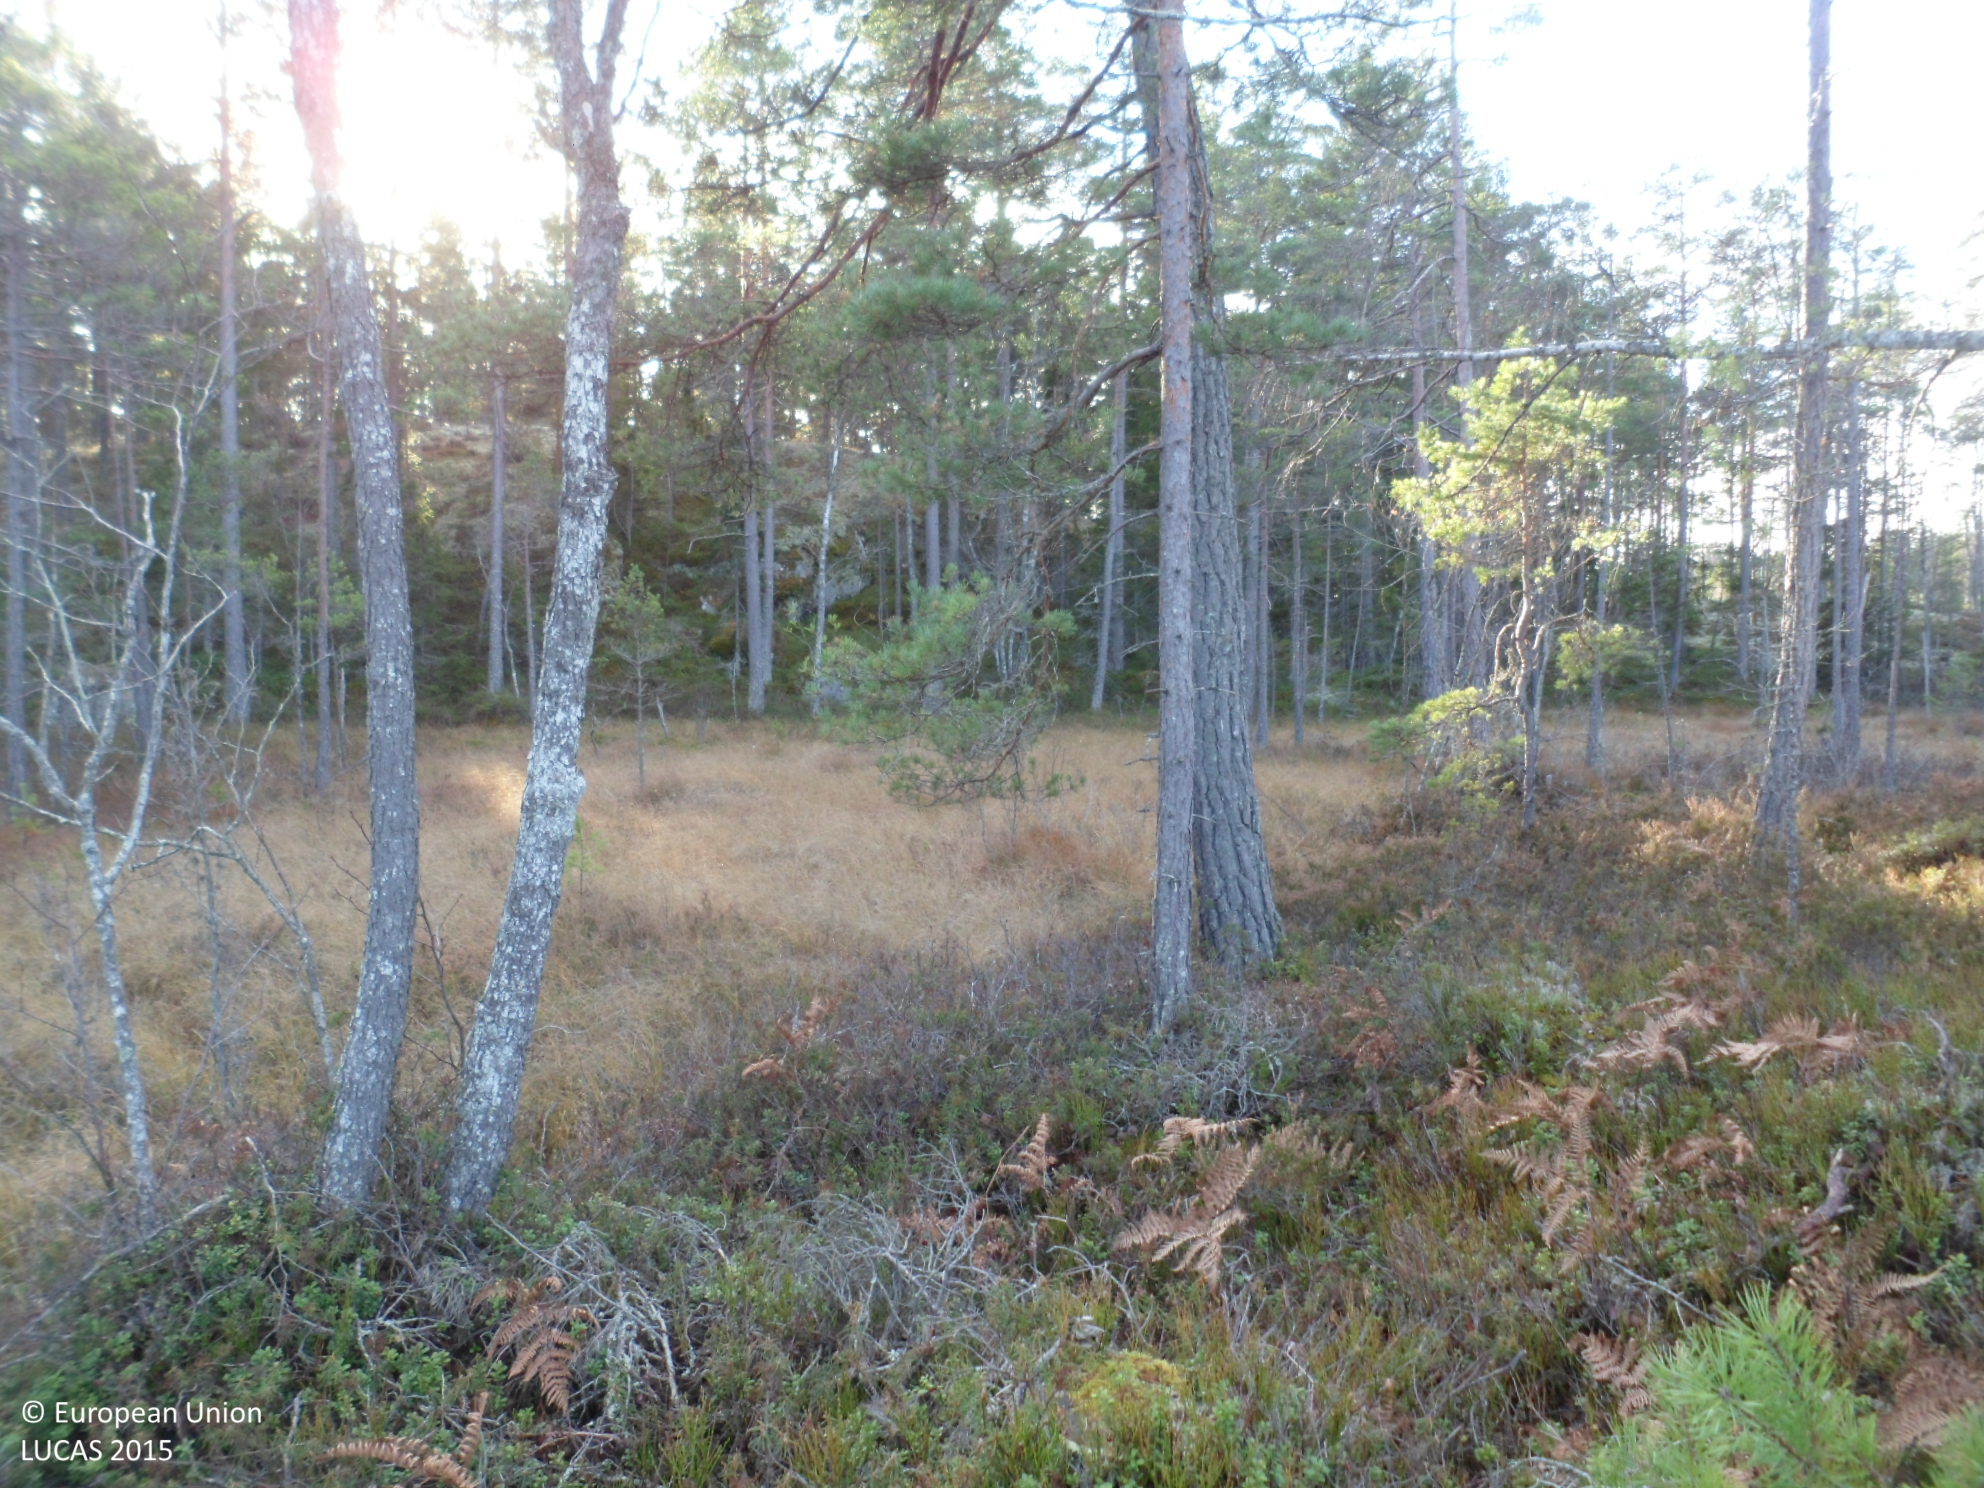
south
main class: Woodland
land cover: Pine dominated coniferous woodland
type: boreal forest
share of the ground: 25 - 50 %
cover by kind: coniferous forest trees 40 %, shrubs 35 %, broadleaved forest trees 10 %, lichens and mosses 10 %, herbaceous plants 5 %
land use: Forestry
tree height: > 5 m
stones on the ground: 25 - 50 %
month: November
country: SE
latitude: 57.2207
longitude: 15.9770
